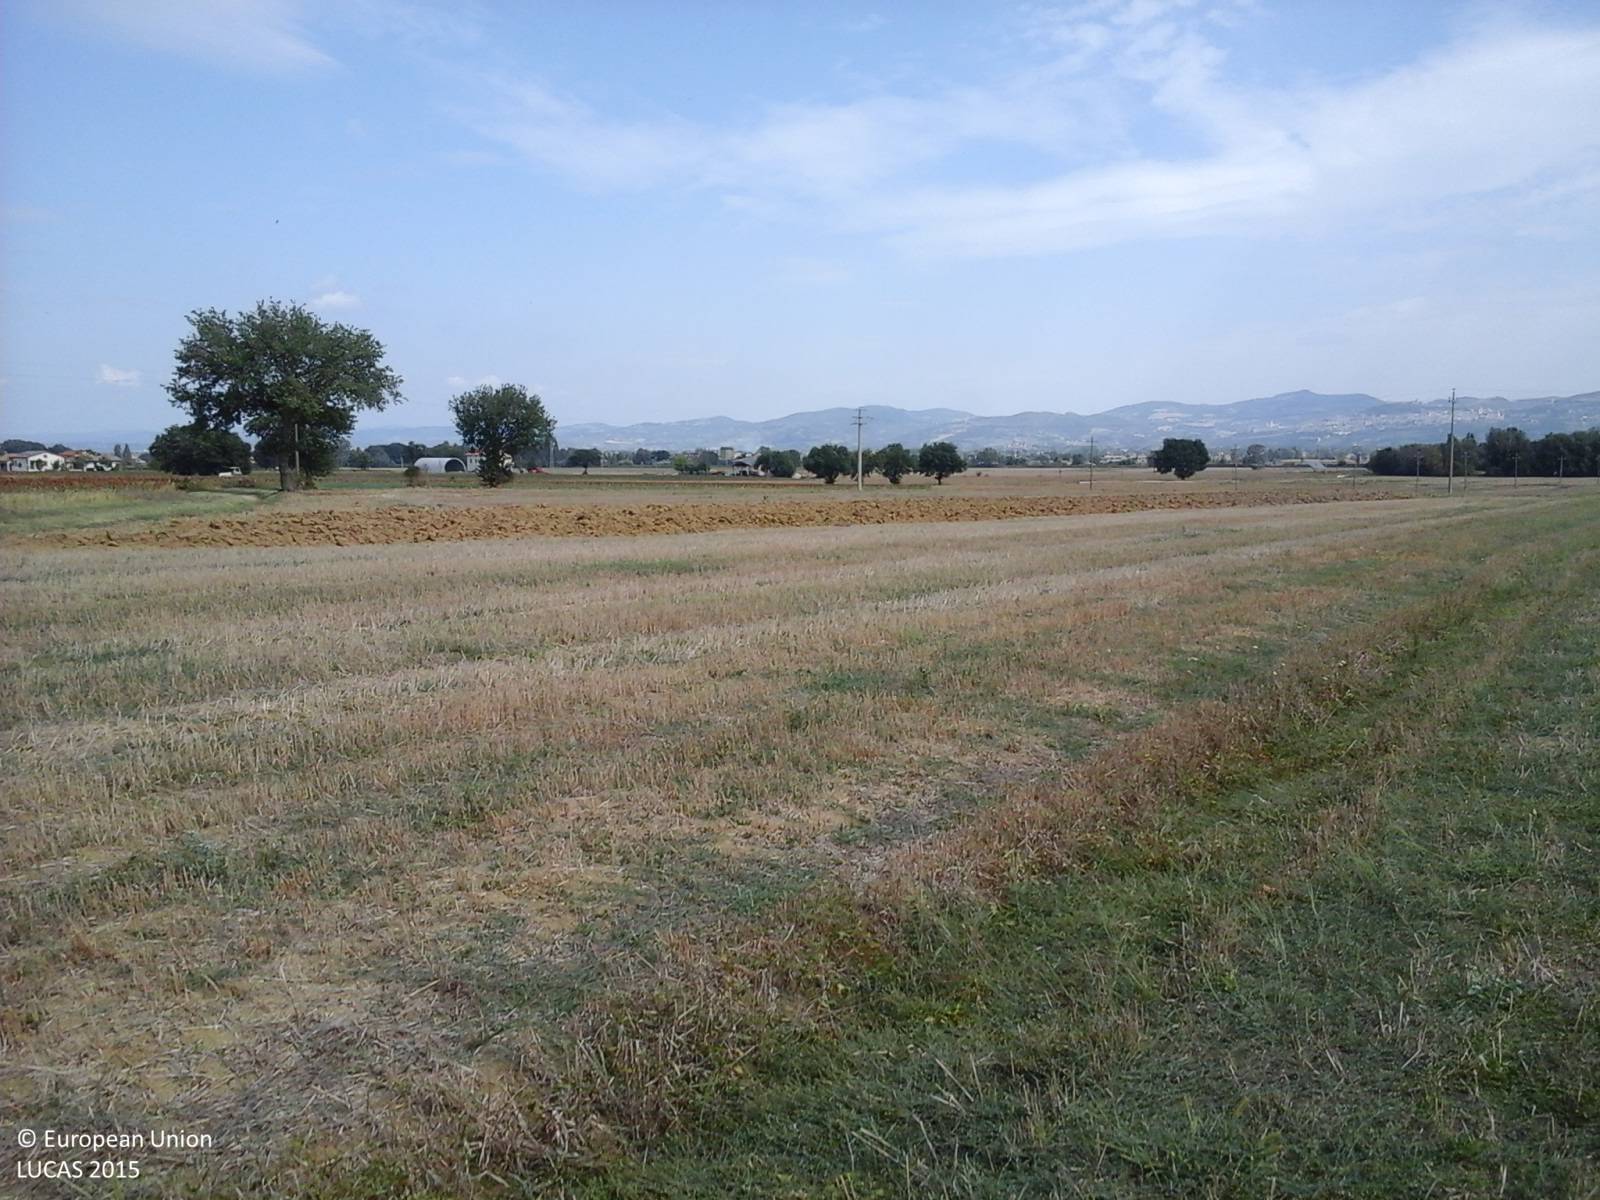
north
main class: Cropland
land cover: Durum wheat
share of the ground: < 10 %
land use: Agriculture (excluding fallow land and kitchen gardens)
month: September
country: IT
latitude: 43.0012
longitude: 12.5563
